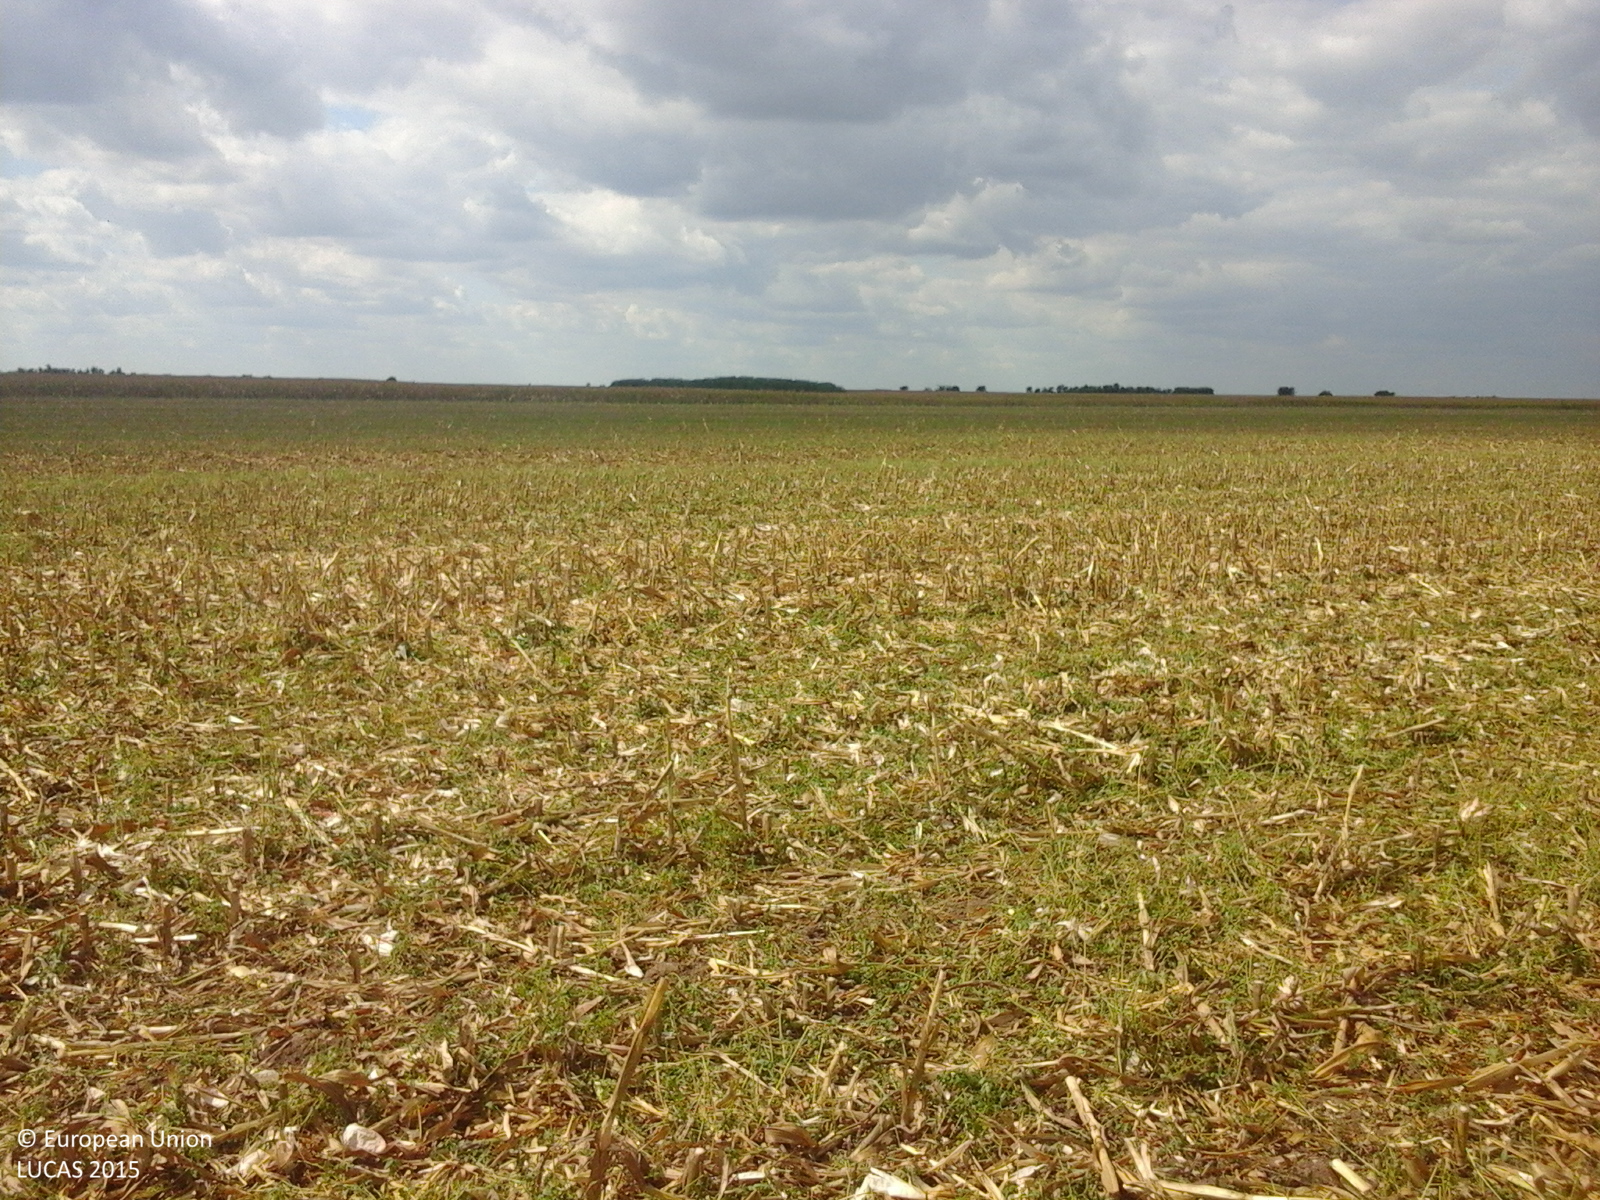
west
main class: Cropland
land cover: Maize
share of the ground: 10 - 25 %
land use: Agriculture (excluding fallow land and kitchen gardens)
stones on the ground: < 10 %
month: September
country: RO
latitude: 47.5499
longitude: 22.6160
